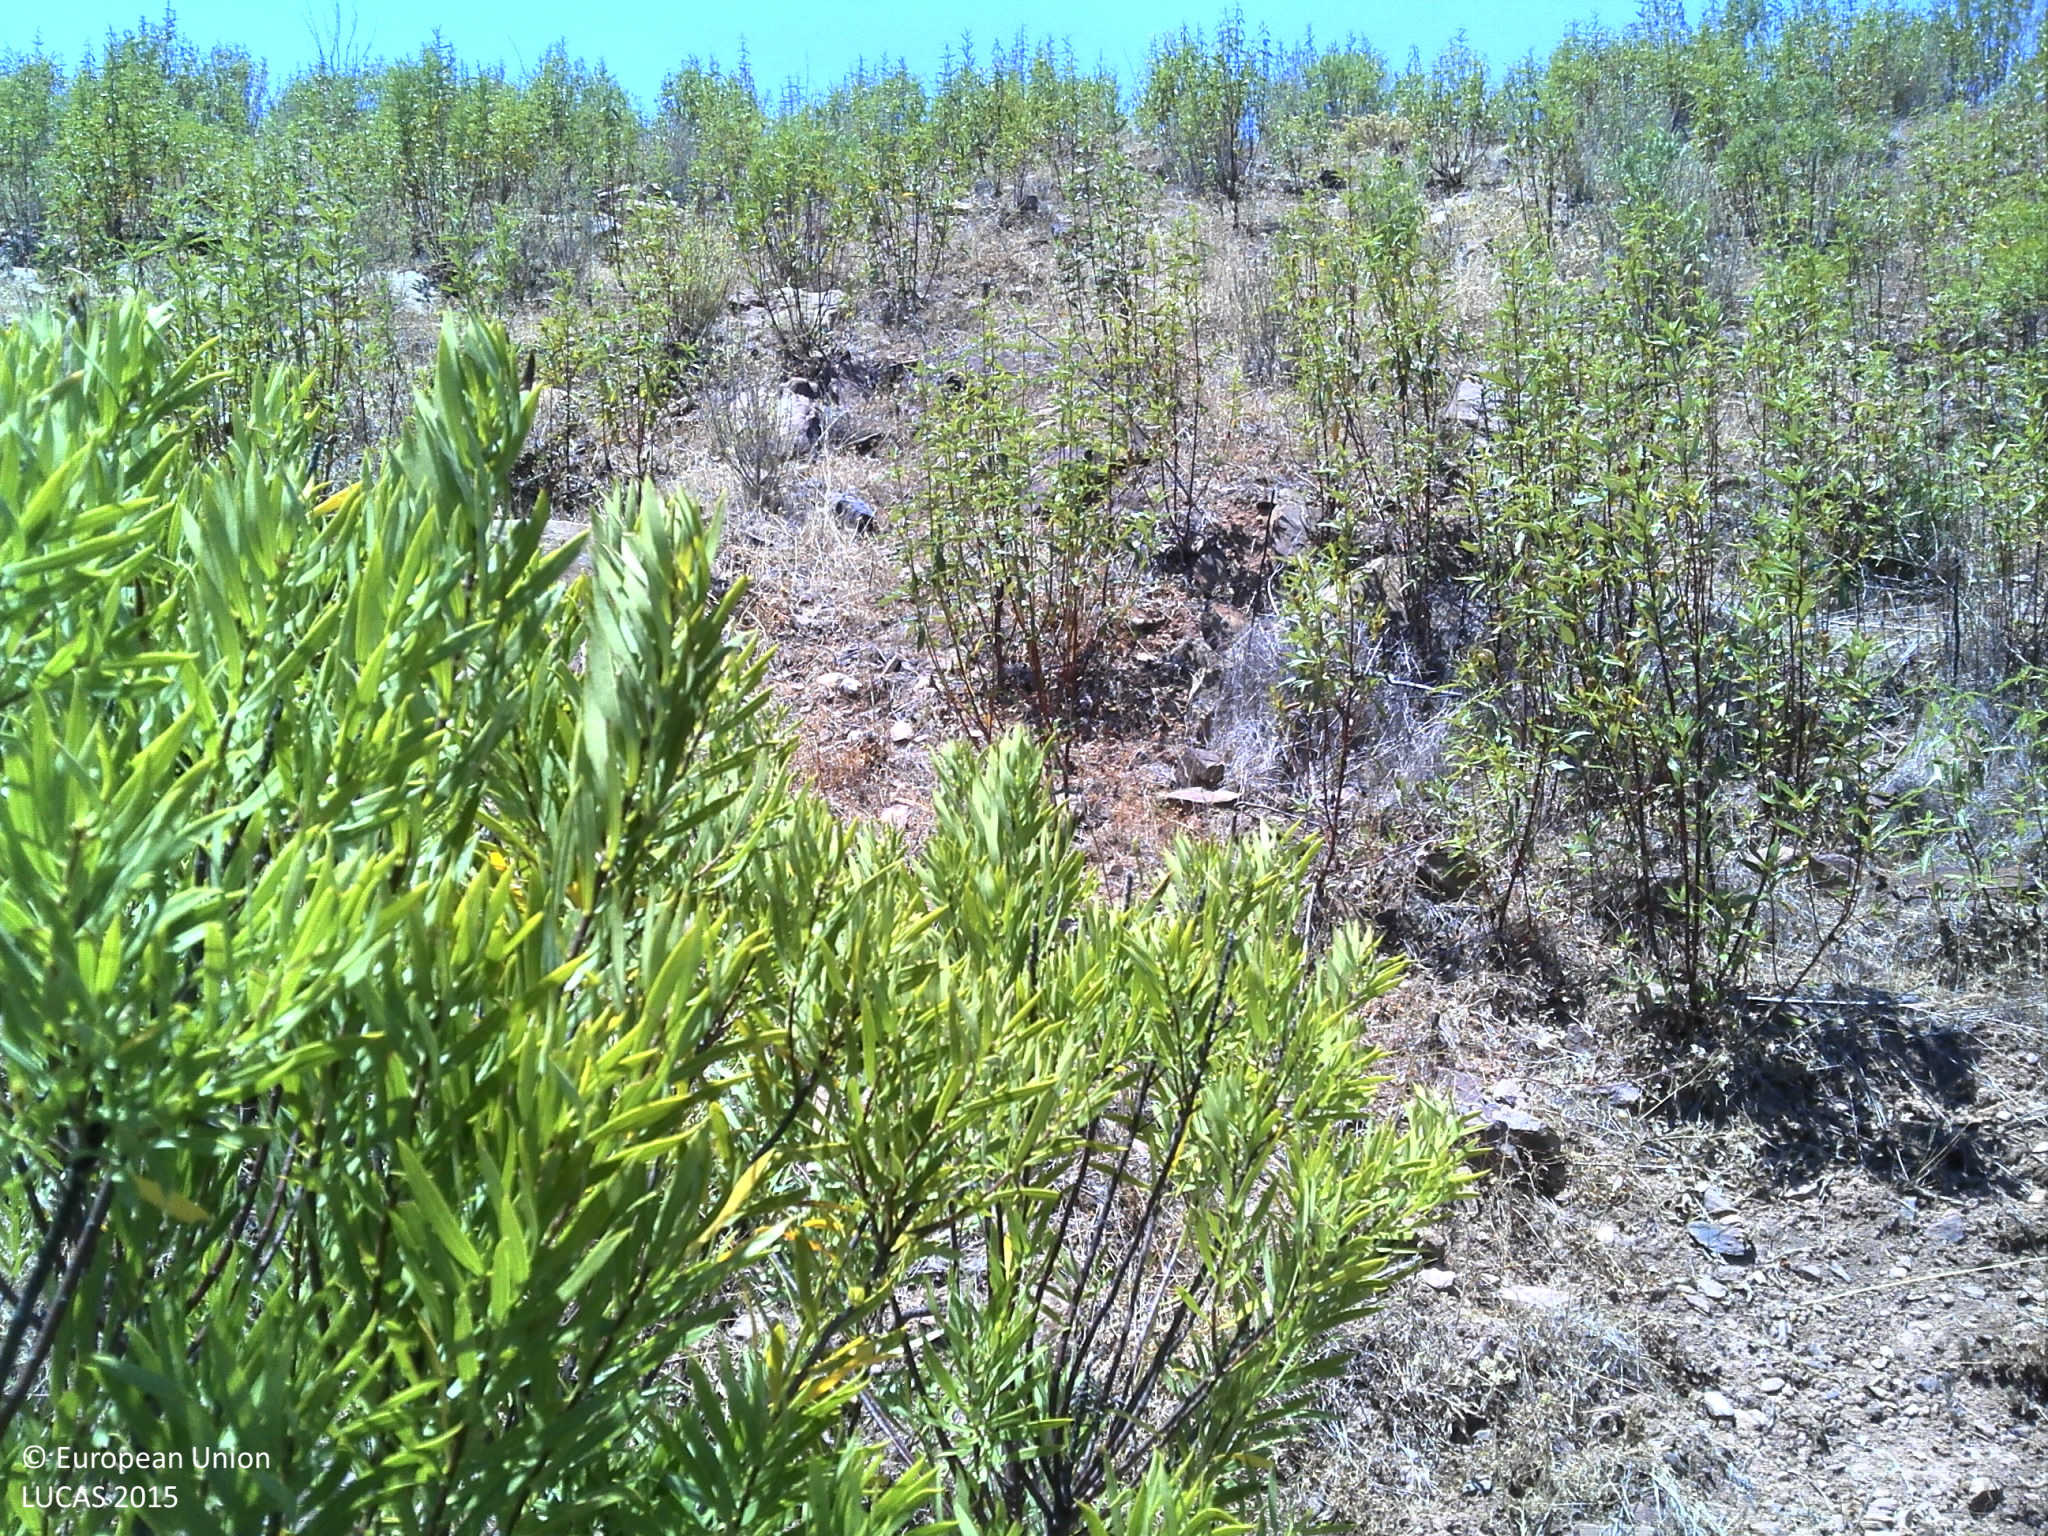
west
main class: Shrubland
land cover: Shrubland without tree cover
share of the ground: 50 - 75 %
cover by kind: shrubs 75 %, unconsolidated bare surface 15 %, herbaceous plants 10 %
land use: Abandoned areas
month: June
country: PT
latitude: 37.1960
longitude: -7.7294
